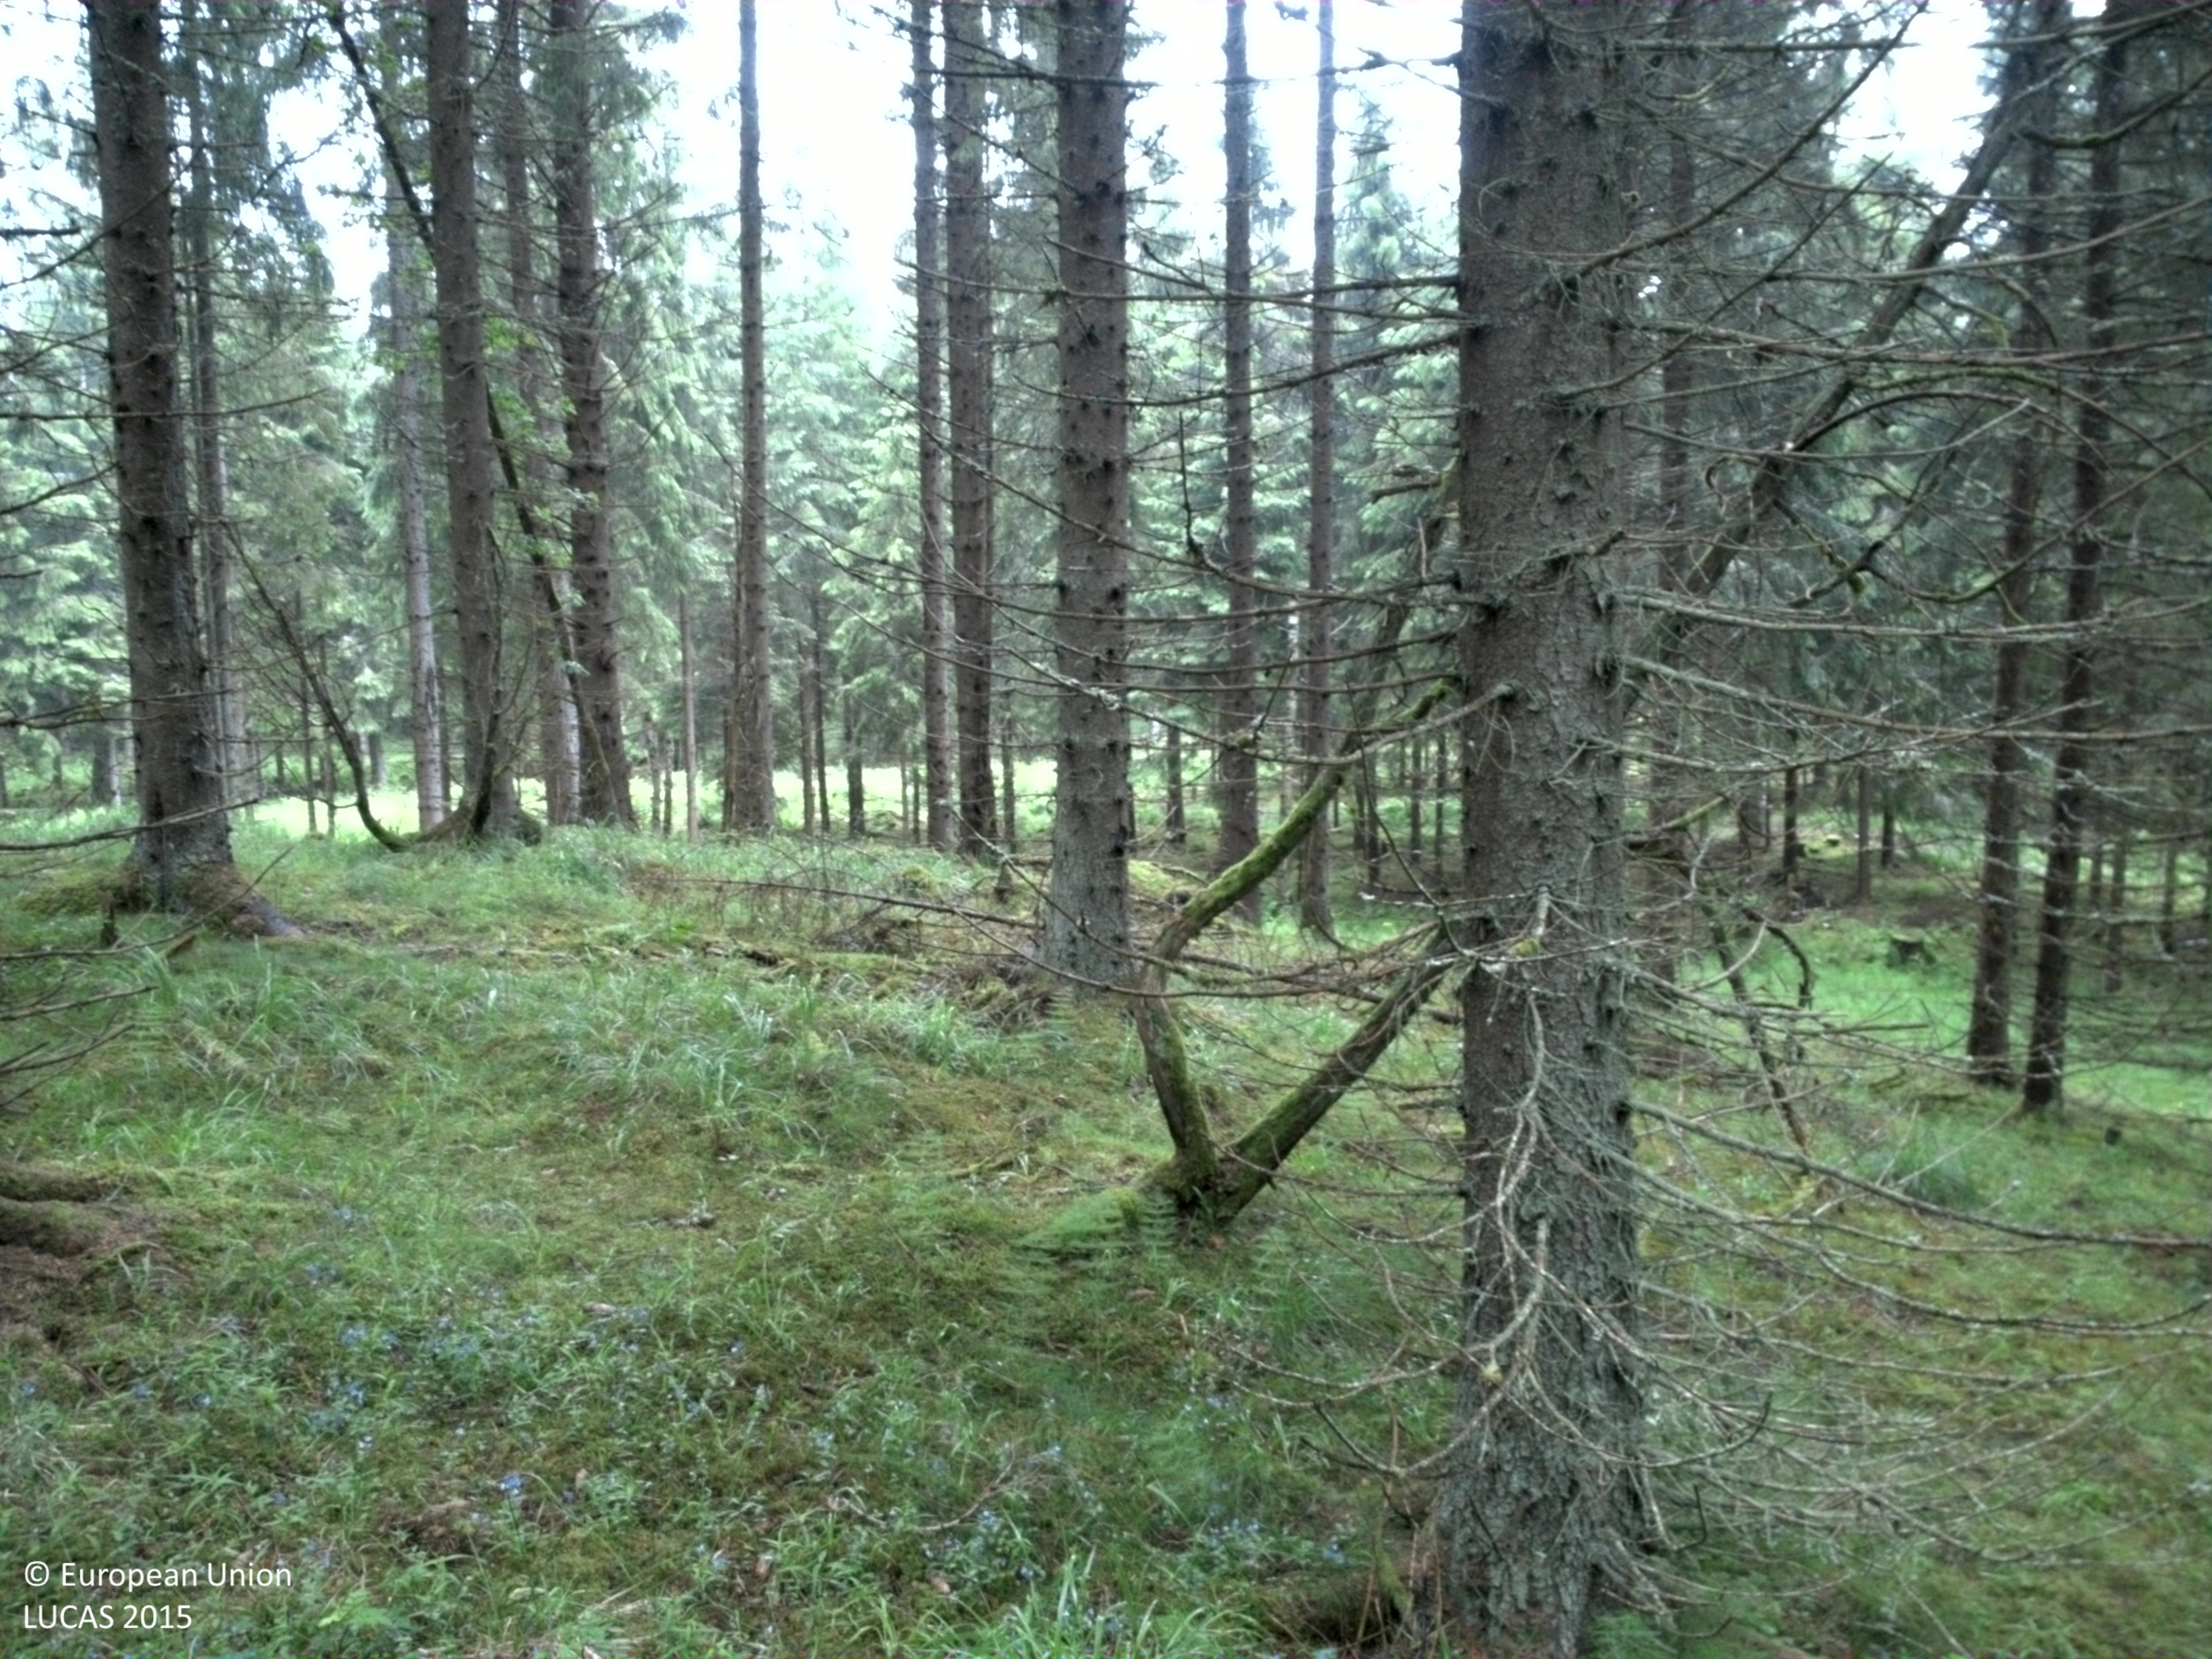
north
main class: Woodland
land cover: Spruce dominated coniferous woodland
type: boreal forest
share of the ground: 50 - 75 %
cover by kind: coniferous forest trees 60 %, herbaceous plants 20 %, lichens and mosses 20 %
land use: Forestry
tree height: > 5 m
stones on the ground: < 10 %
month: June
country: SE
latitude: 58.6870
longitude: 15.4276
